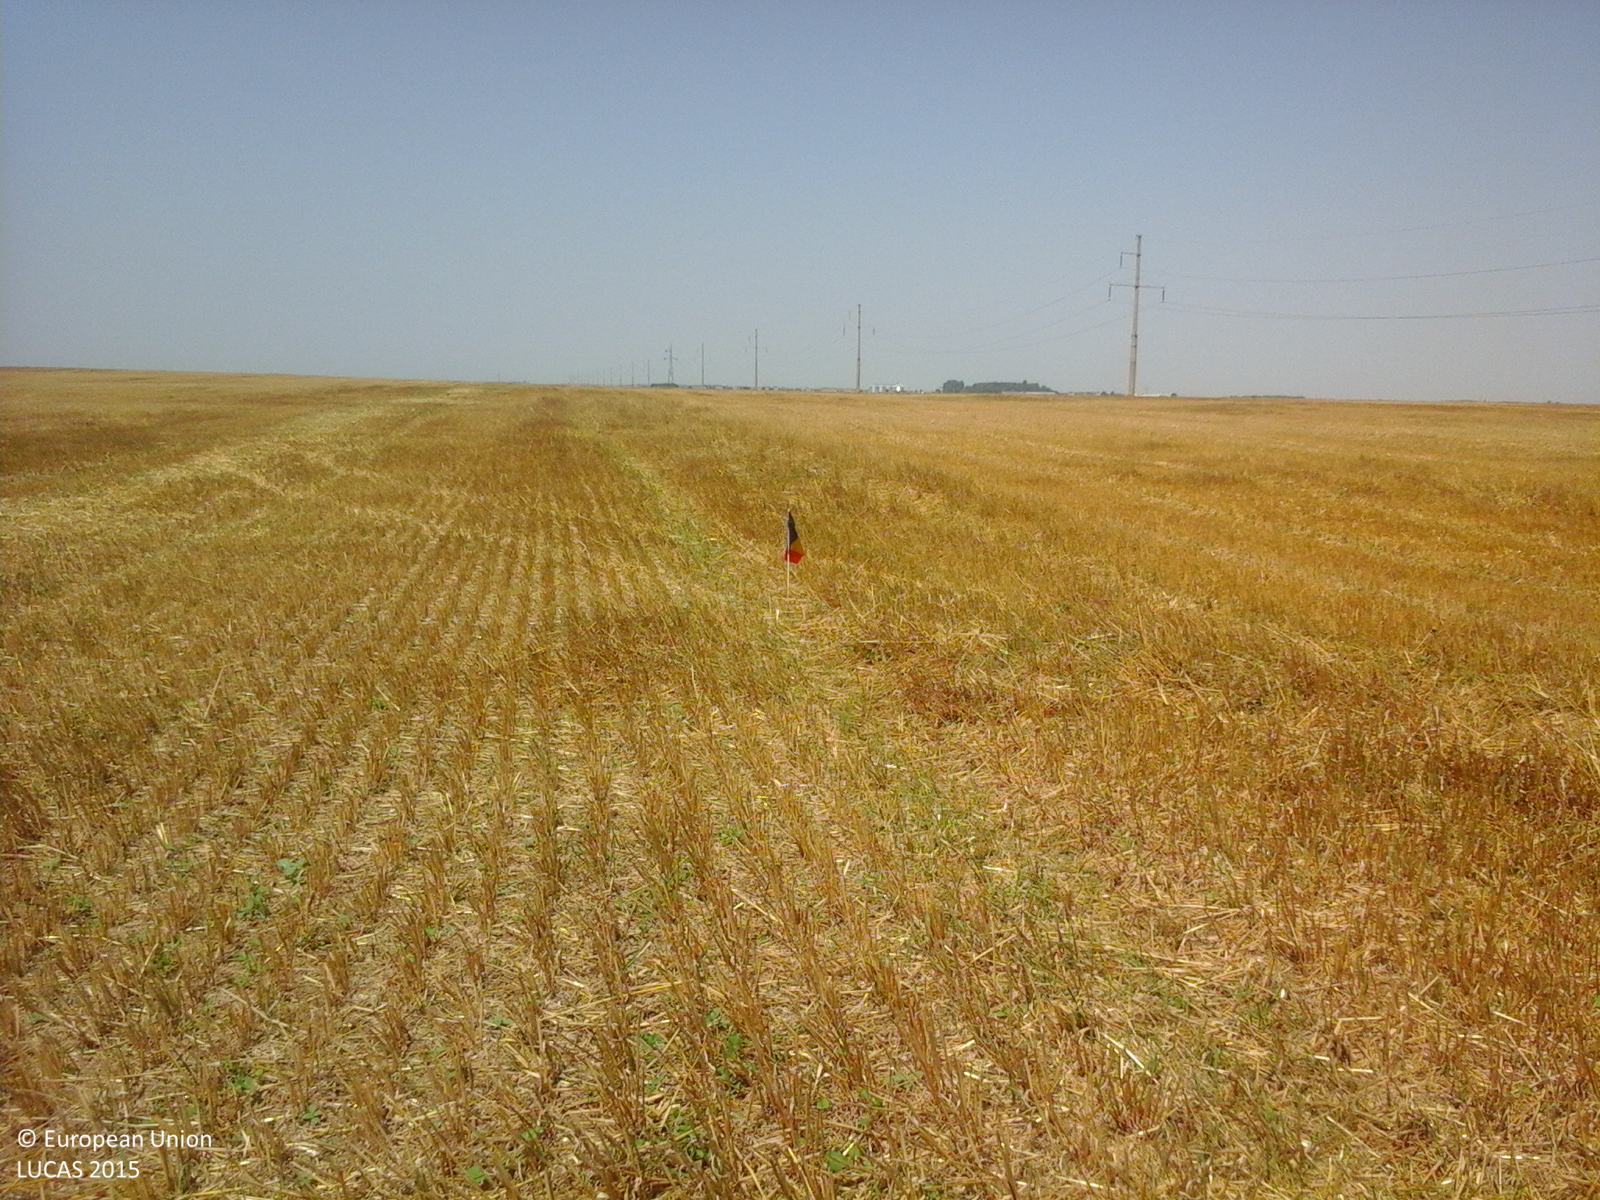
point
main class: Cropland
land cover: Common wheat
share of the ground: 25 - 50 %
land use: Agriculture (excluding fallow land and kitchen gardens)
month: July
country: RO
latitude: 44.5290
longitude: 27.2622
